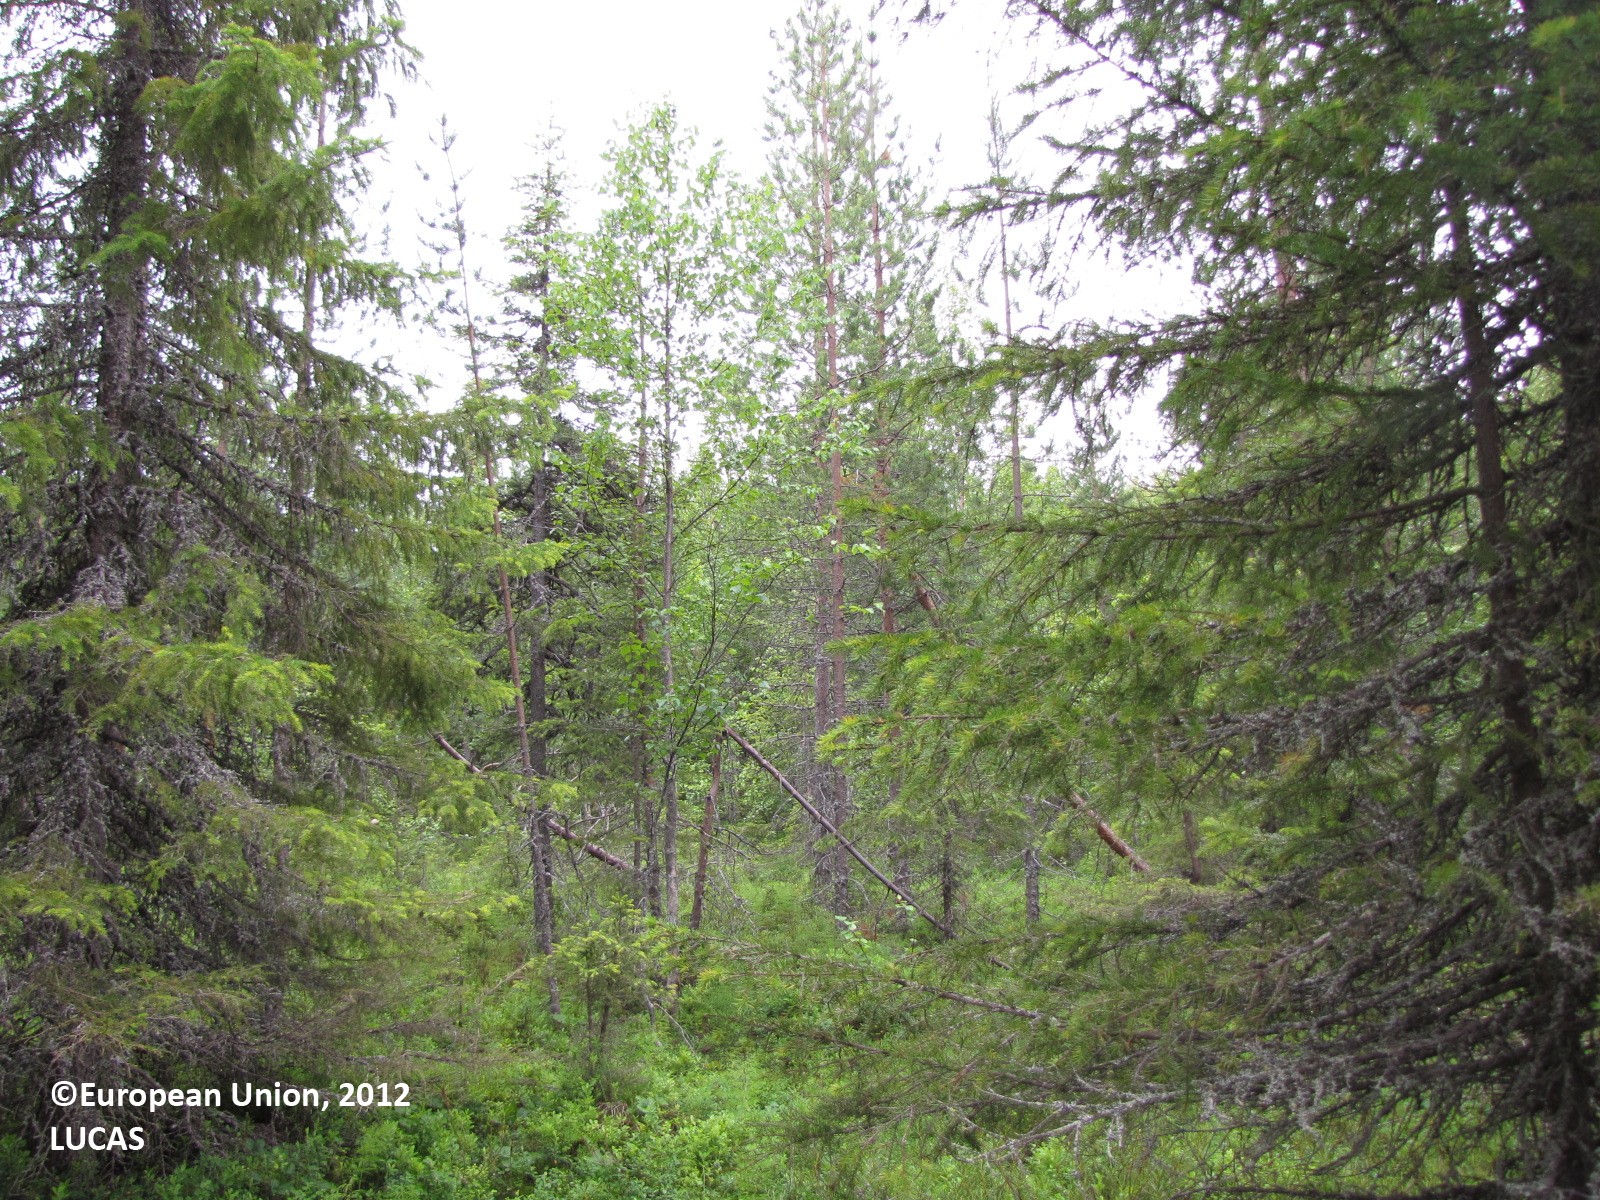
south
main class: Woodland
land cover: Spruce dominated mixed woodland
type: boreal forest
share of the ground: 25 - 50 %
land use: Forestry
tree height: > 5 m
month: July
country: FI
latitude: 66.5324
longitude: 24.9266
